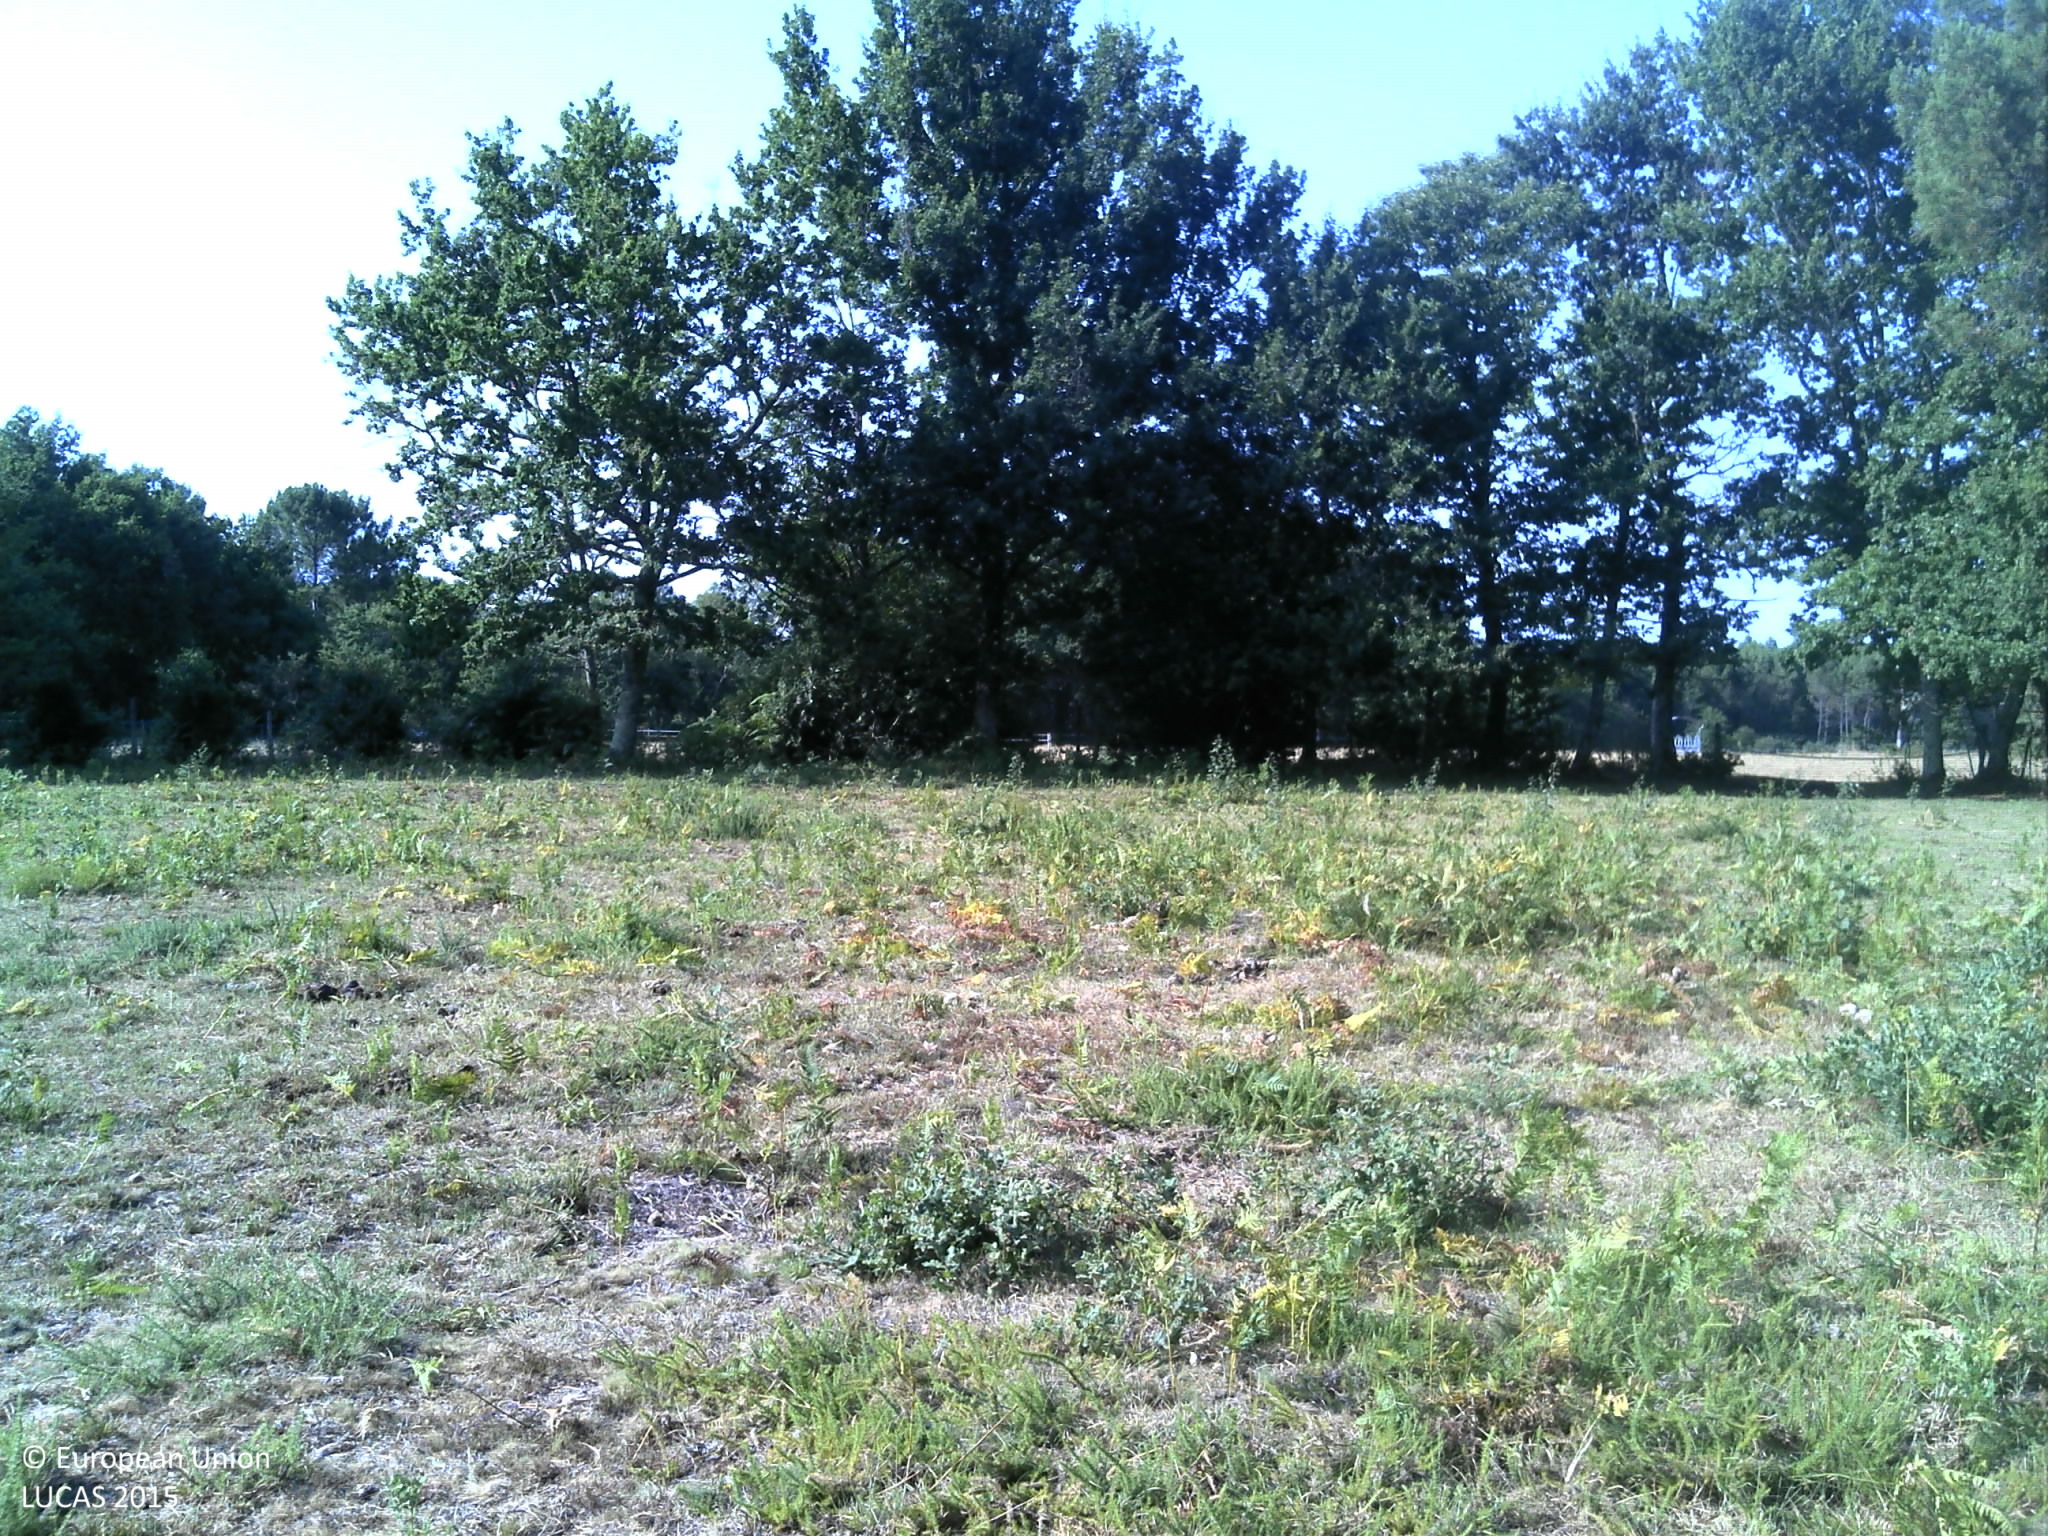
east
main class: Grassland
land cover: Spontaneously vegetated surfaces
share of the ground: > 75 %
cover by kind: herbaceous plants 95 %, shrubs 5 %
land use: Semi-natural and natural areas not in use
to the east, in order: Spontaneously vegetated surfaces; Pine dominated mixed woodland; Ditches and canals; Grass margins; Tracks; Grass margins; Ditches and canals; Pine dominated mixed woodland
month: July
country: FR
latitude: 44.5840
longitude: -0.4572
